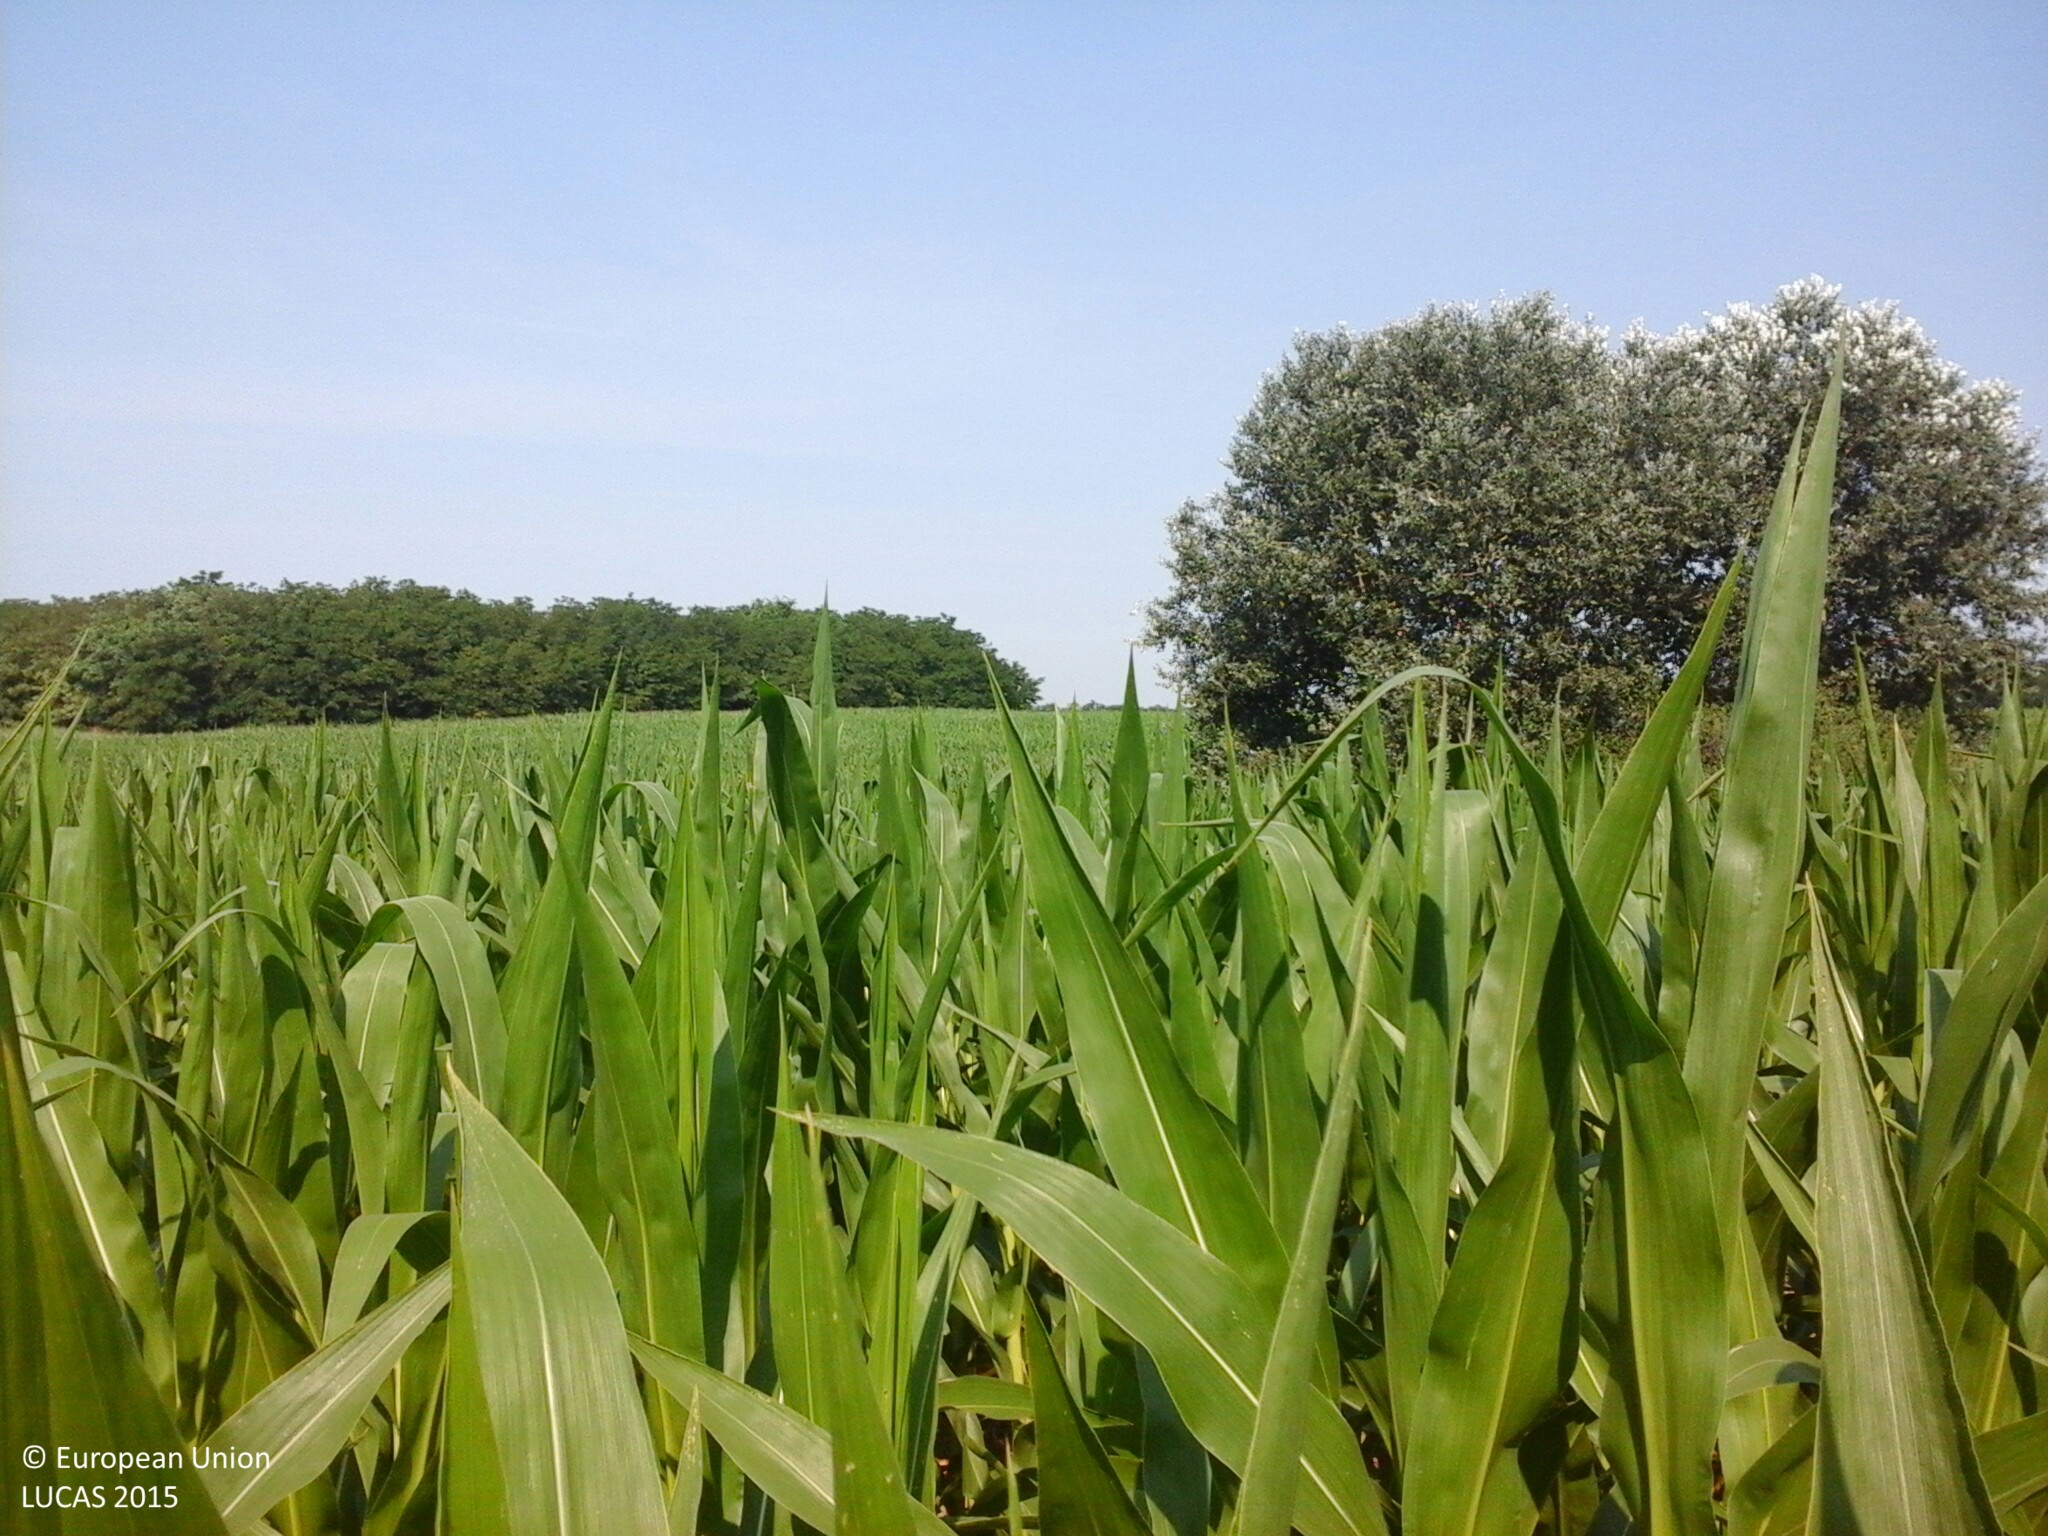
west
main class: Cropland
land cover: Maize
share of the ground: > 75 %
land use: Agriculture (excluding fallow land and kitchen gardens)
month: July
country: HU
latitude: 48.1473
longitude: 22.1653
